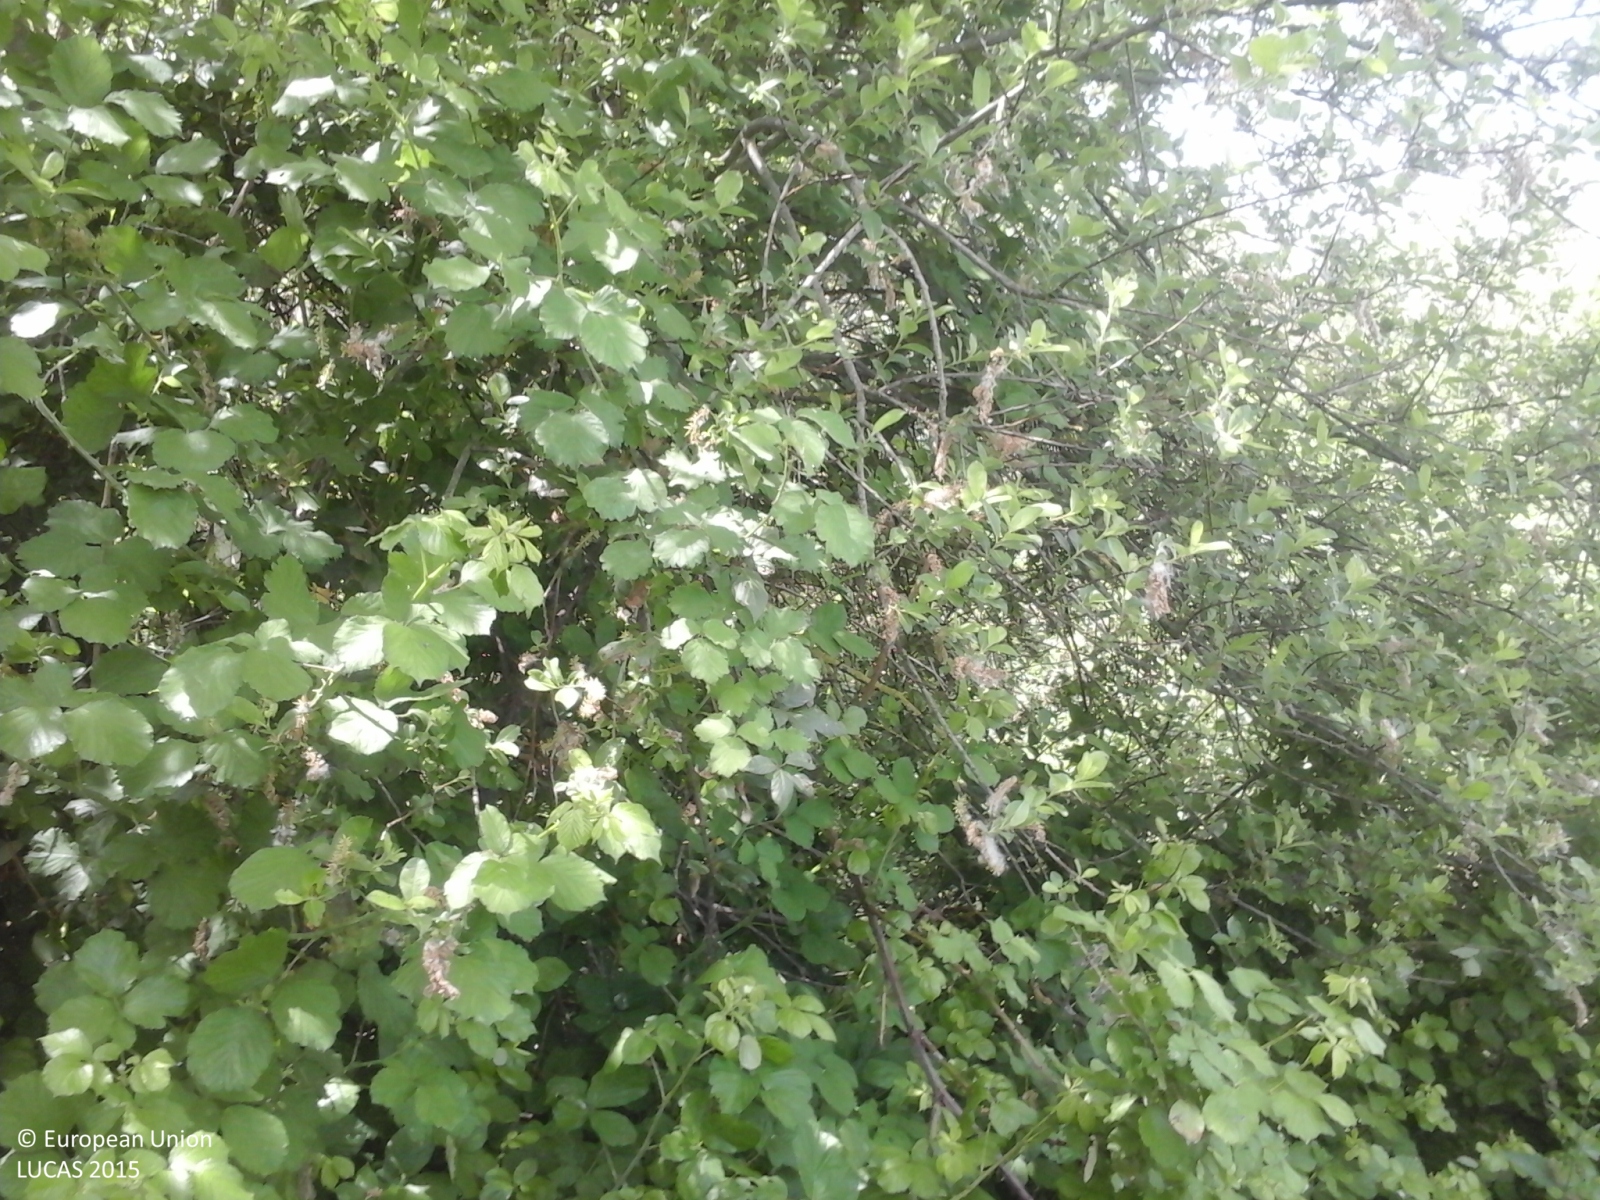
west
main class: Grassland
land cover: Spontaneously vegetated surfaces
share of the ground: > 75 %
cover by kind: herbaceous plants 100 %
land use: Agriculture (excluding fallow land and kitchen gardens)
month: May
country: IT
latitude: 44.2383
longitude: 10.9119
